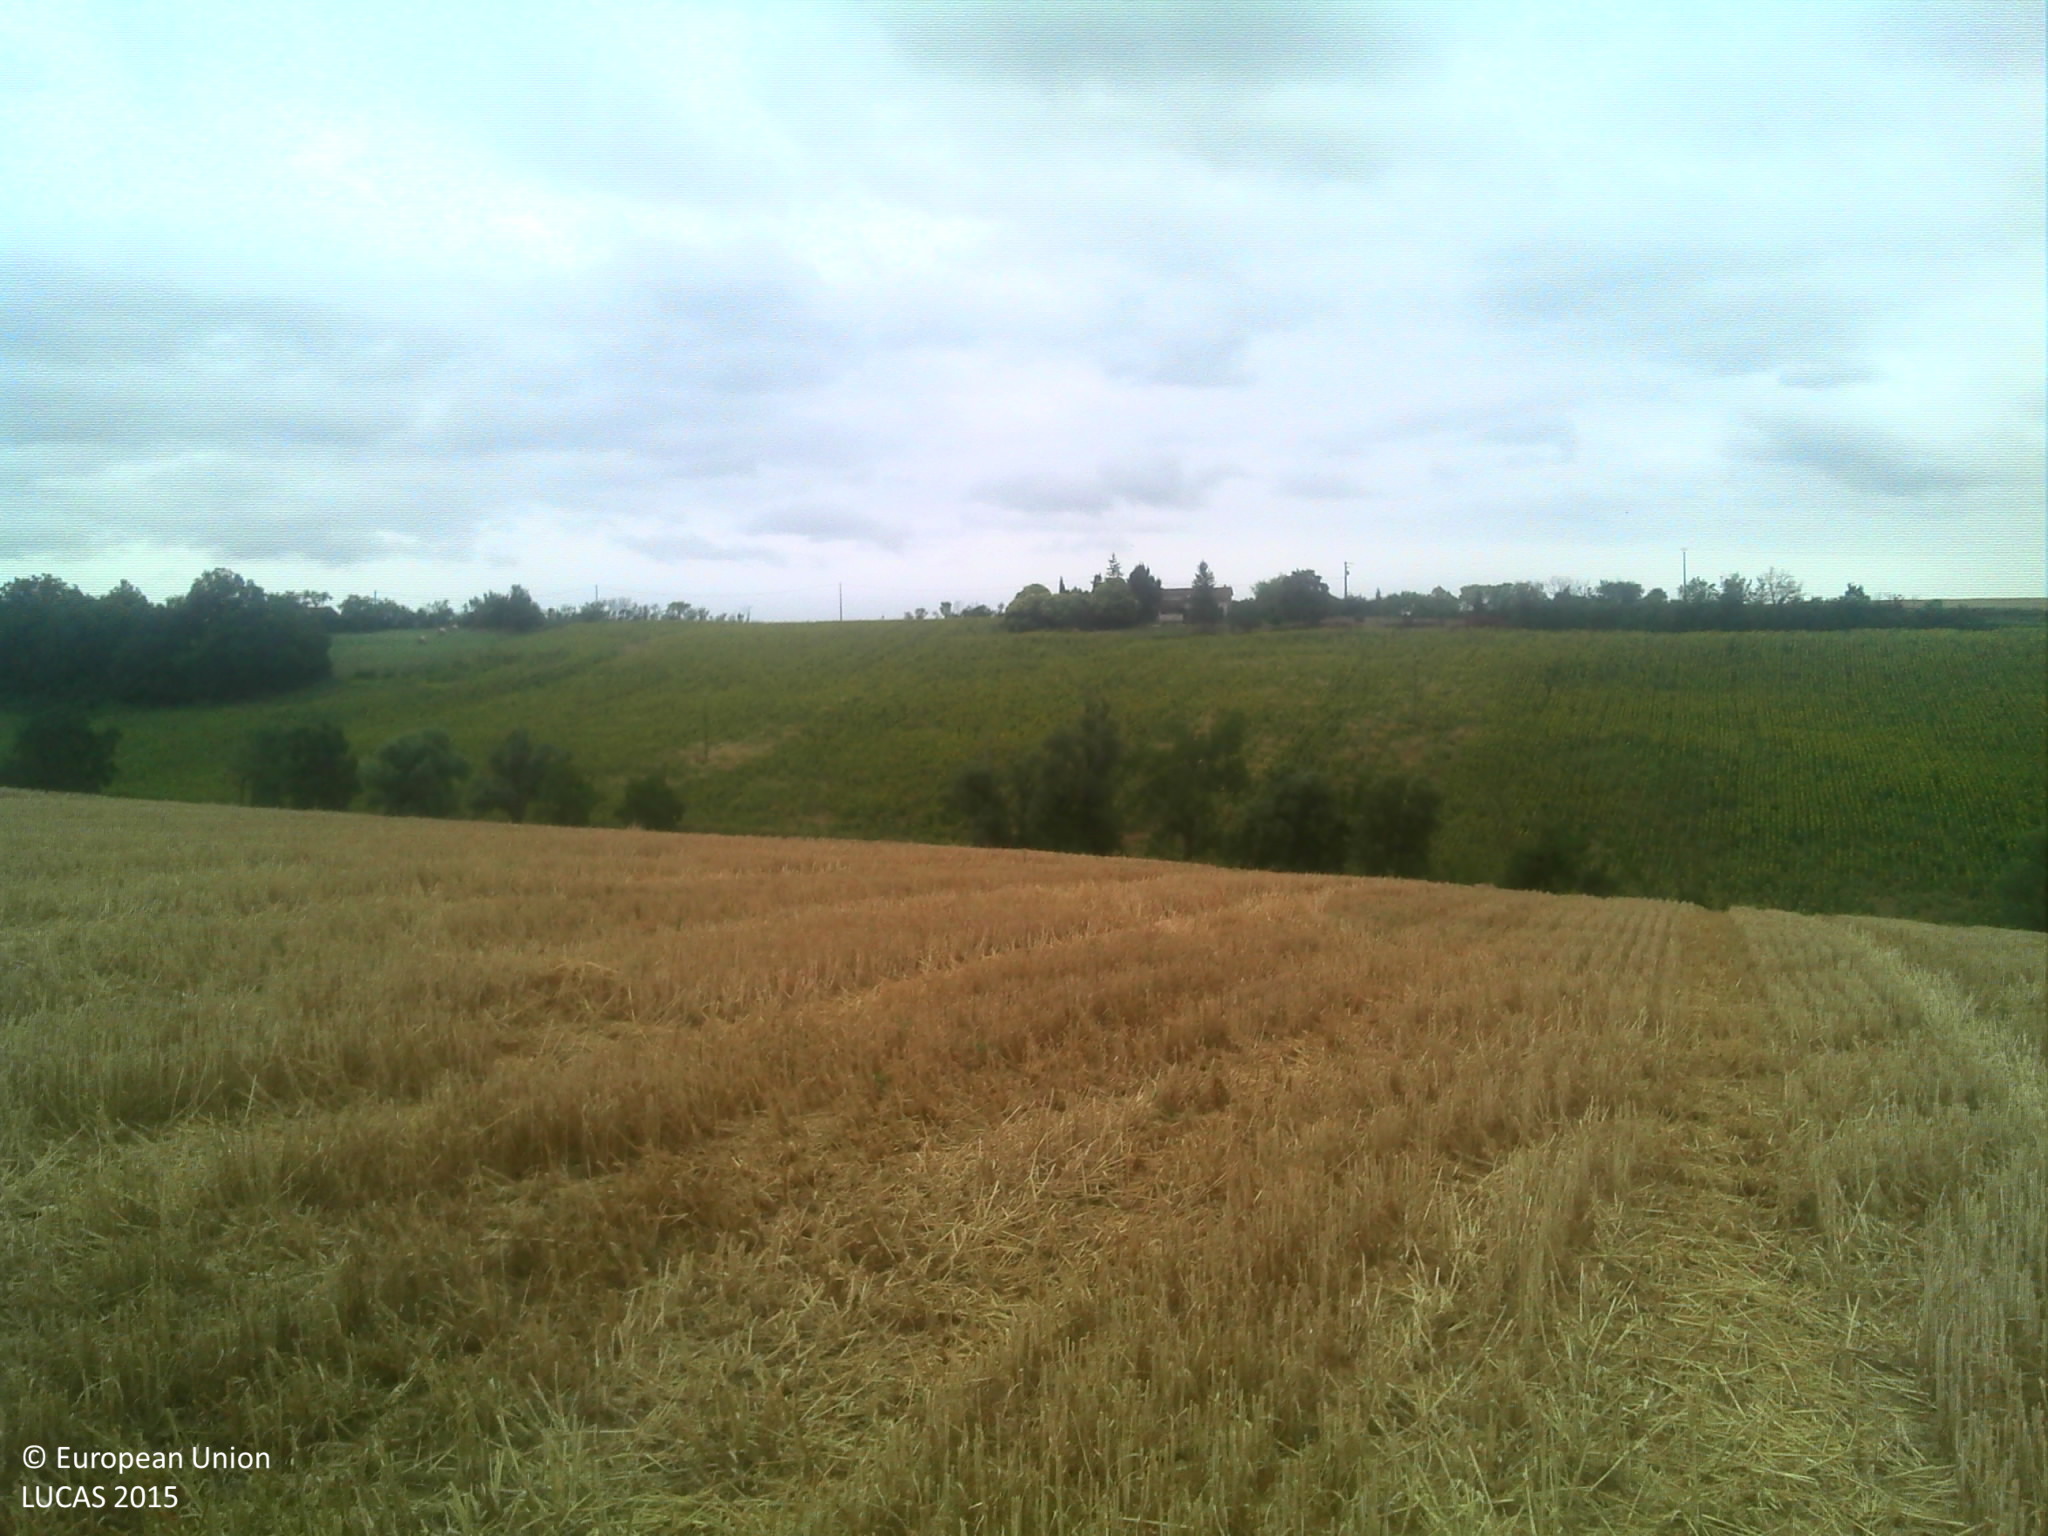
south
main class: Cropland
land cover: Common wheat
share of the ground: > 75 %
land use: Agriculture (excluding fallow land and kitchen gardens)
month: July
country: FR
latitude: 43.2332
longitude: 1.4221
